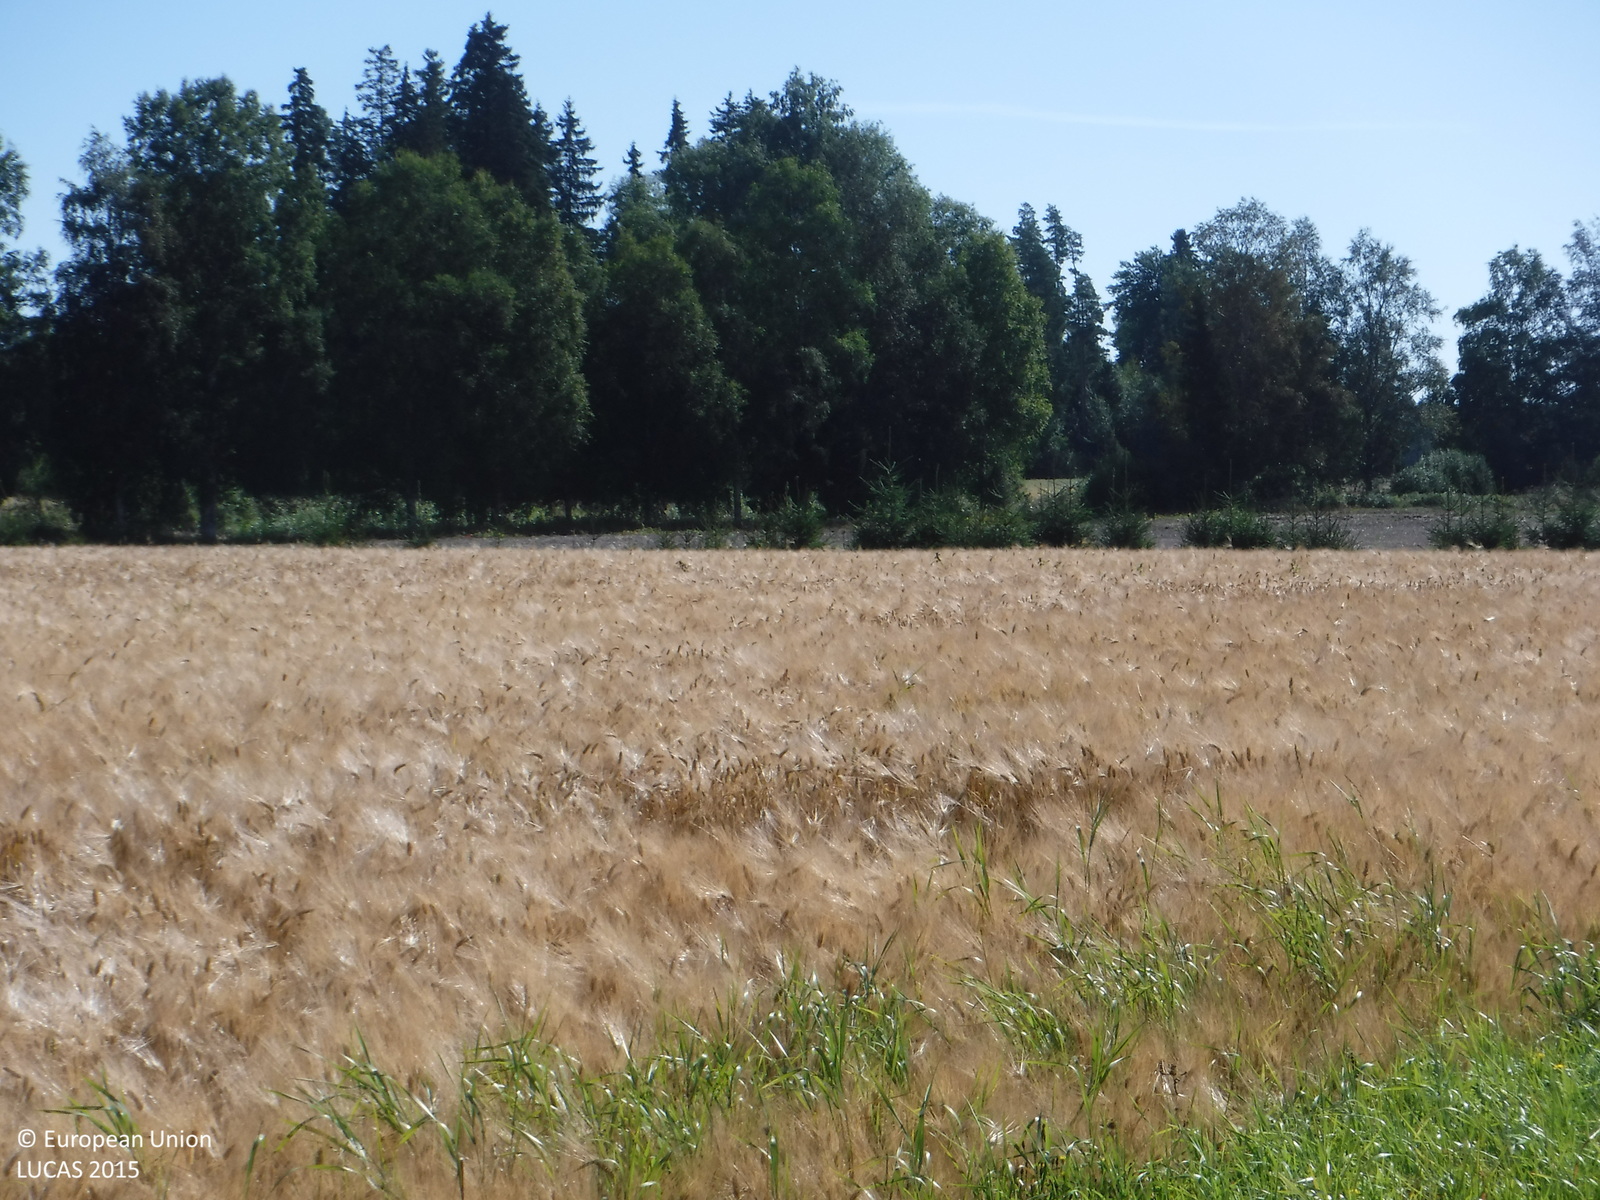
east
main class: Cropland
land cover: Barley
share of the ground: > 75 %
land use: Agriculture (excluding fallow land and kitchen gardens)
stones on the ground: < 10 %
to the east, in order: Barley; Grass margins; Tracks; Grass margins; Common wheat; Grass margins; Ditches and canals; Conifer hedges; Grassland without tree/shrub cover; Other bare soil; Lines of trees; Ponds and wetlands; Inland fresh running water; Broadleaved woodland; Grass margins; Oats
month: August
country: FI
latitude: 61.1297
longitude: 21.7340
